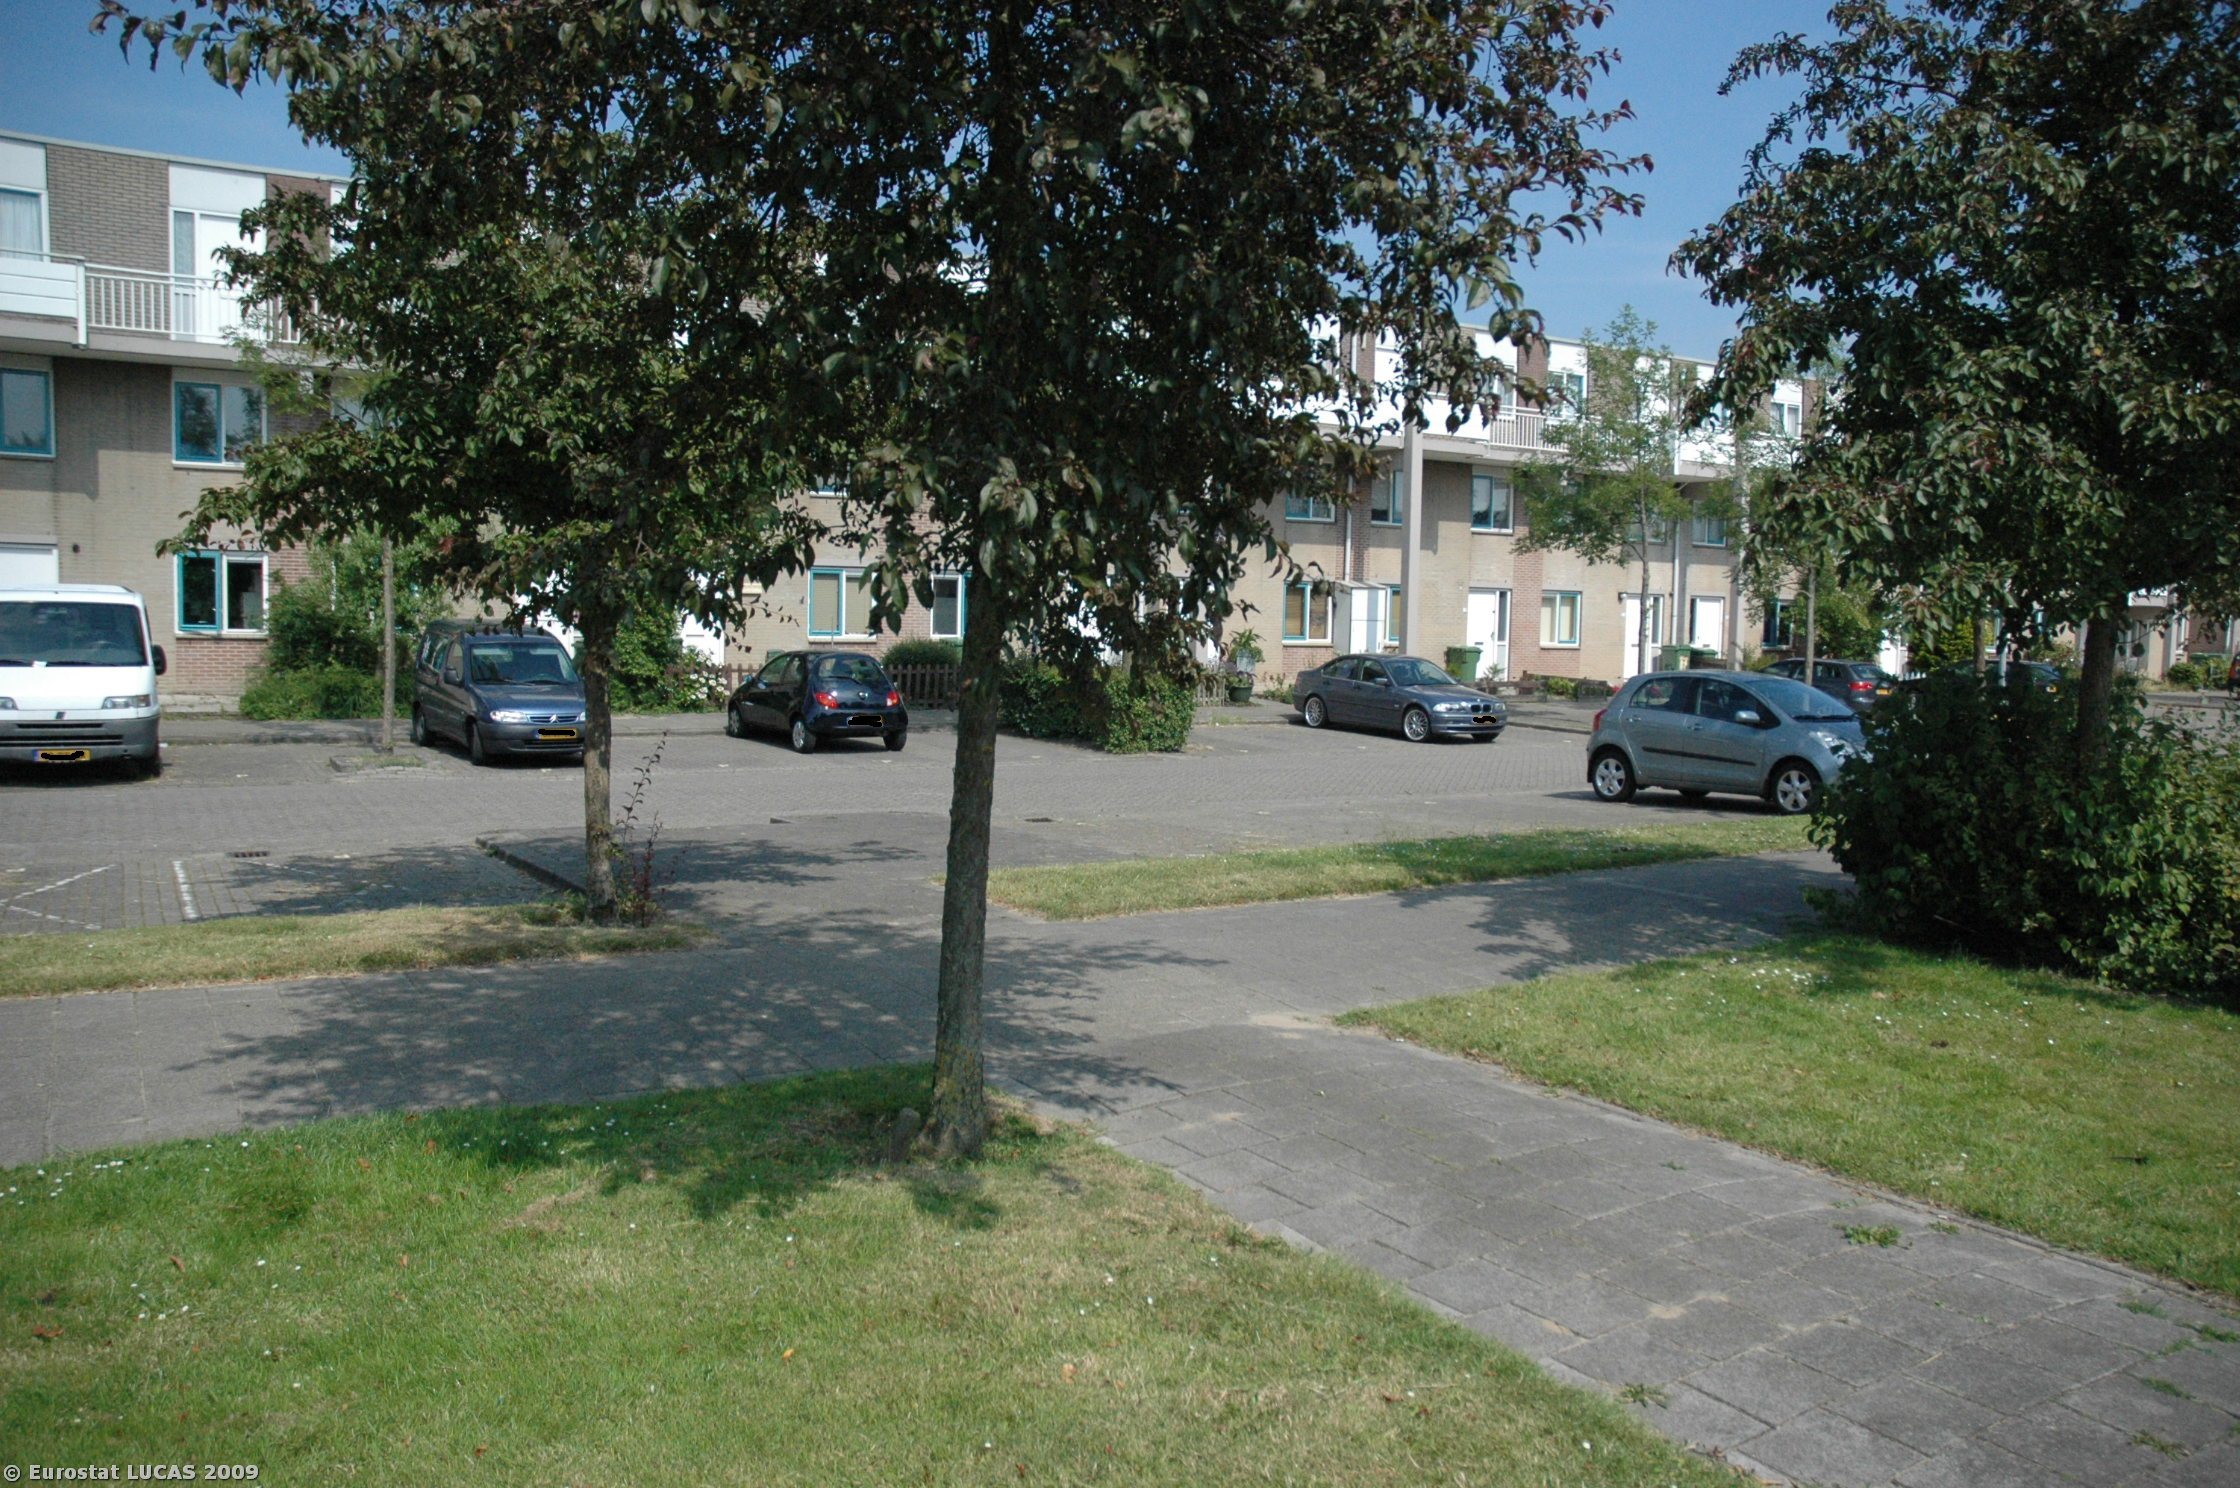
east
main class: Grassland
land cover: Grassland without tree/shrub cover
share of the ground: > 75 %
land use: Residential
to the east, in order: Grassland without tree/shrub cover; Artificial constructions in urban areas
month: June
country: NL
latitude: 52.3918
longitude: 5.2810
